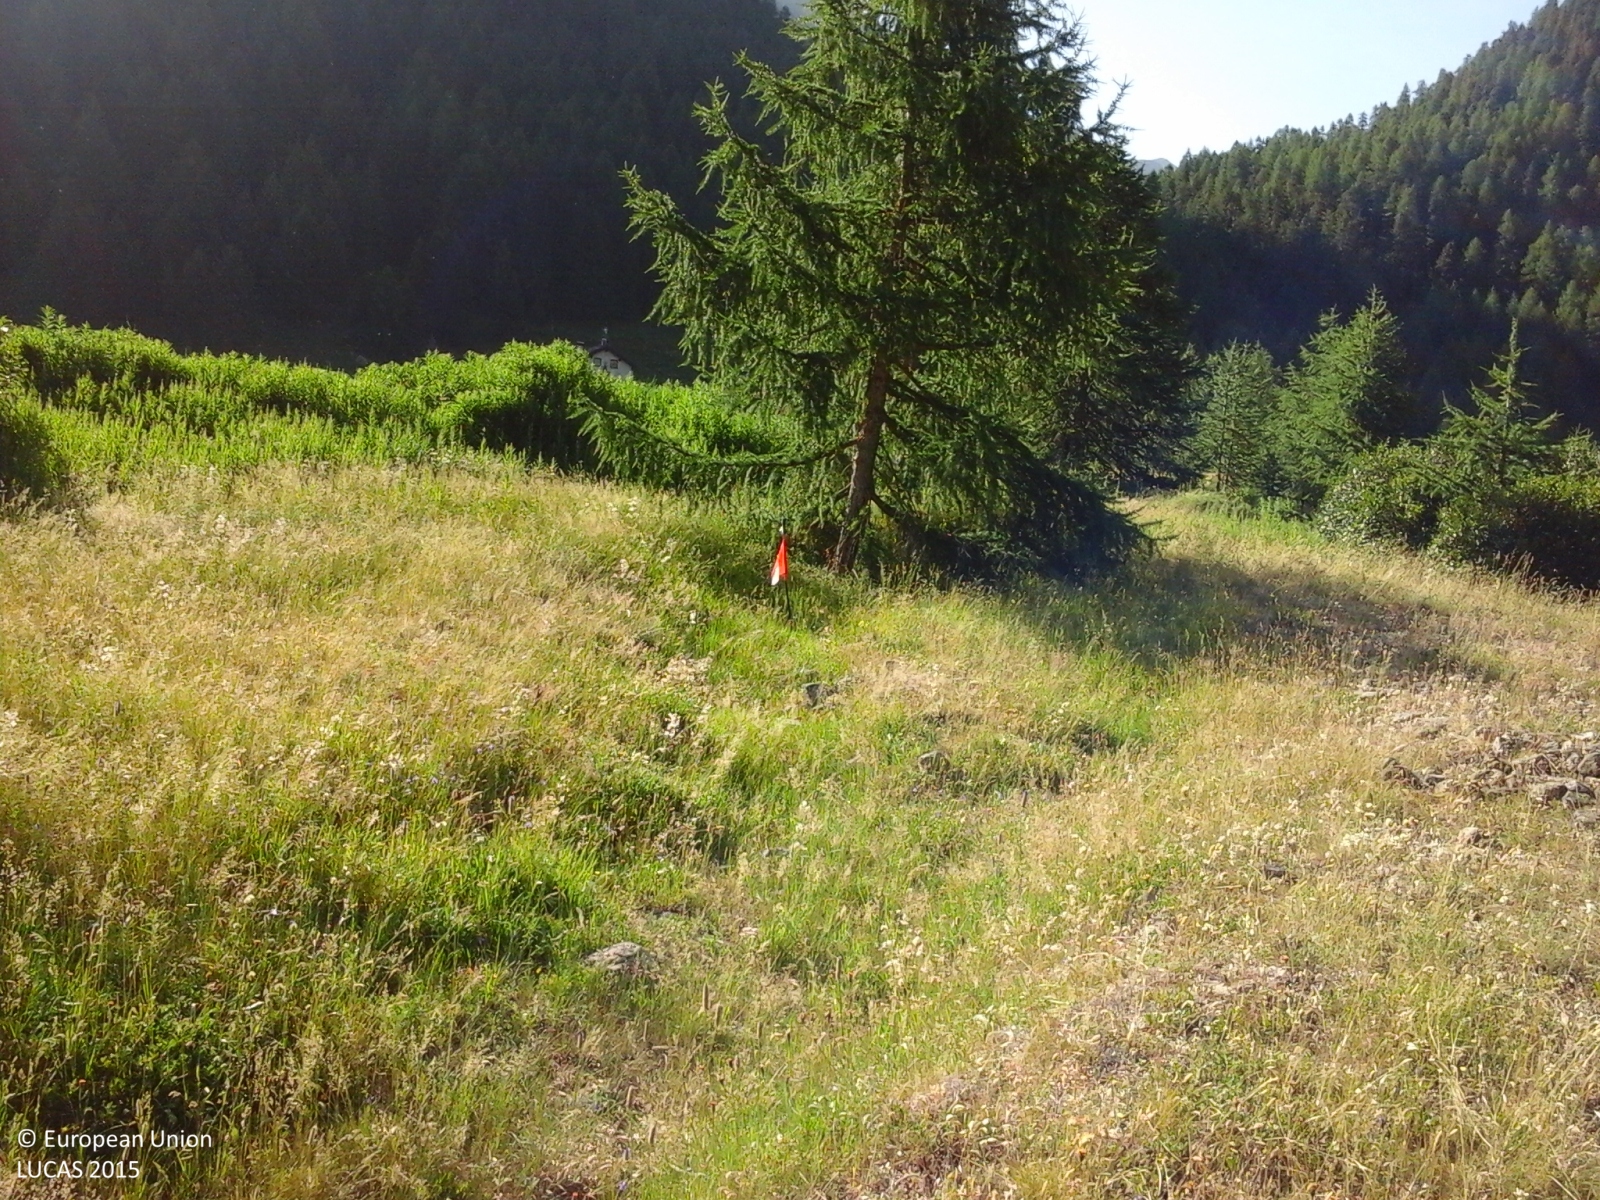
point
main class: Woodland
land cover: Other coniferous woodland
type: alpine coniferous forest
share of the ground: > 75 %
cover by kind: herbaceous plants 80 %, coniferous forest trees 20 %
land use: Agriculture (excluding fallow land and kitchen gardens)
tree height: > 5 m
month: July
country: IT
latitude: 46.4952
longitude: 10.1171
